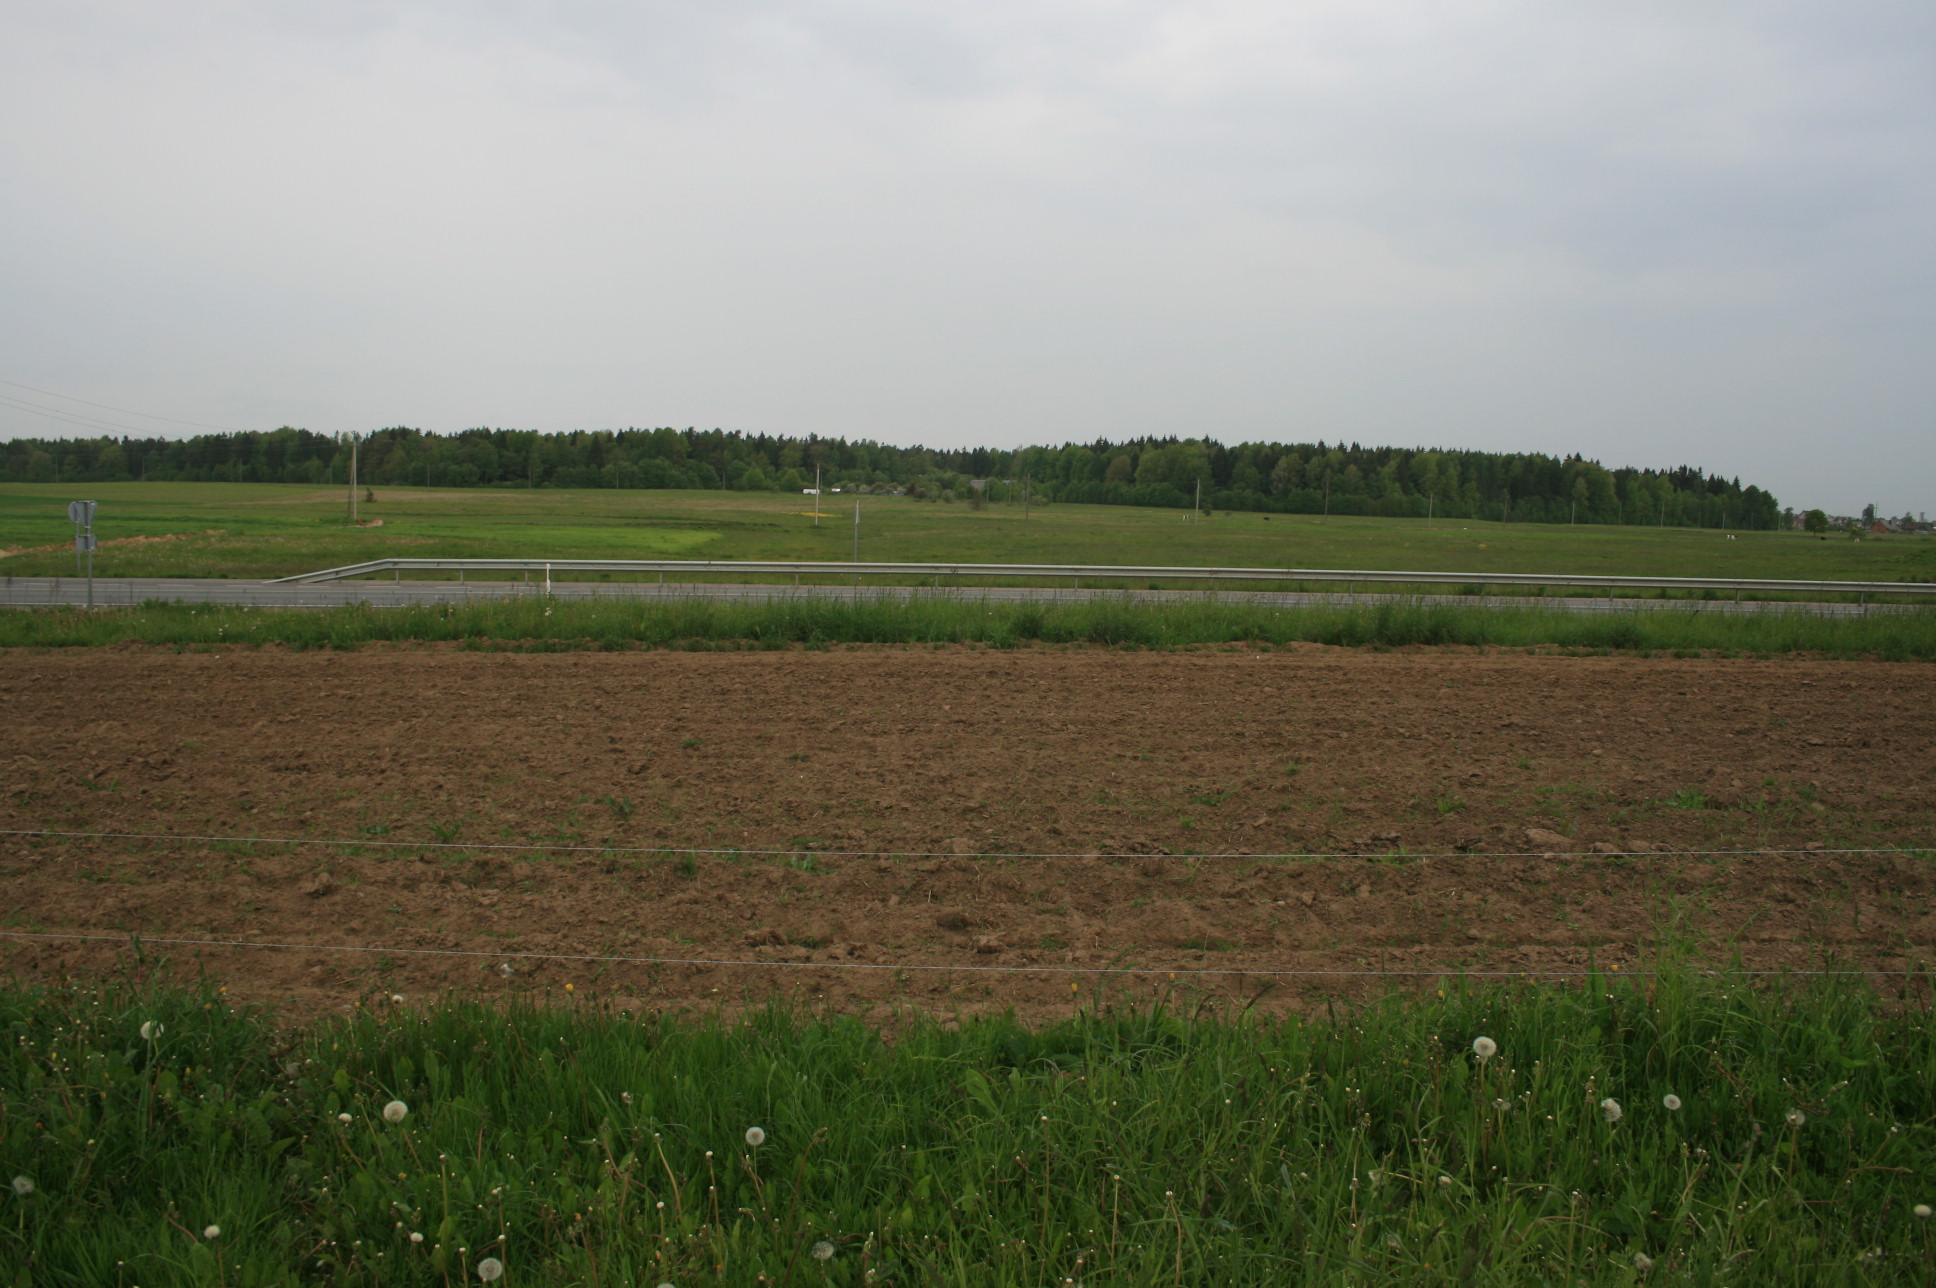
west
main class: Grassland
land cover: Grassland without tree/shrub cover
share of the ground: > 75 %
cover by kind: herbaceous plants 100 %
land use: Agriculture (excluding fallow land and kitchen gardens)
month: May
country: LT
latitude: 55.8896
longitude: 21.8657
